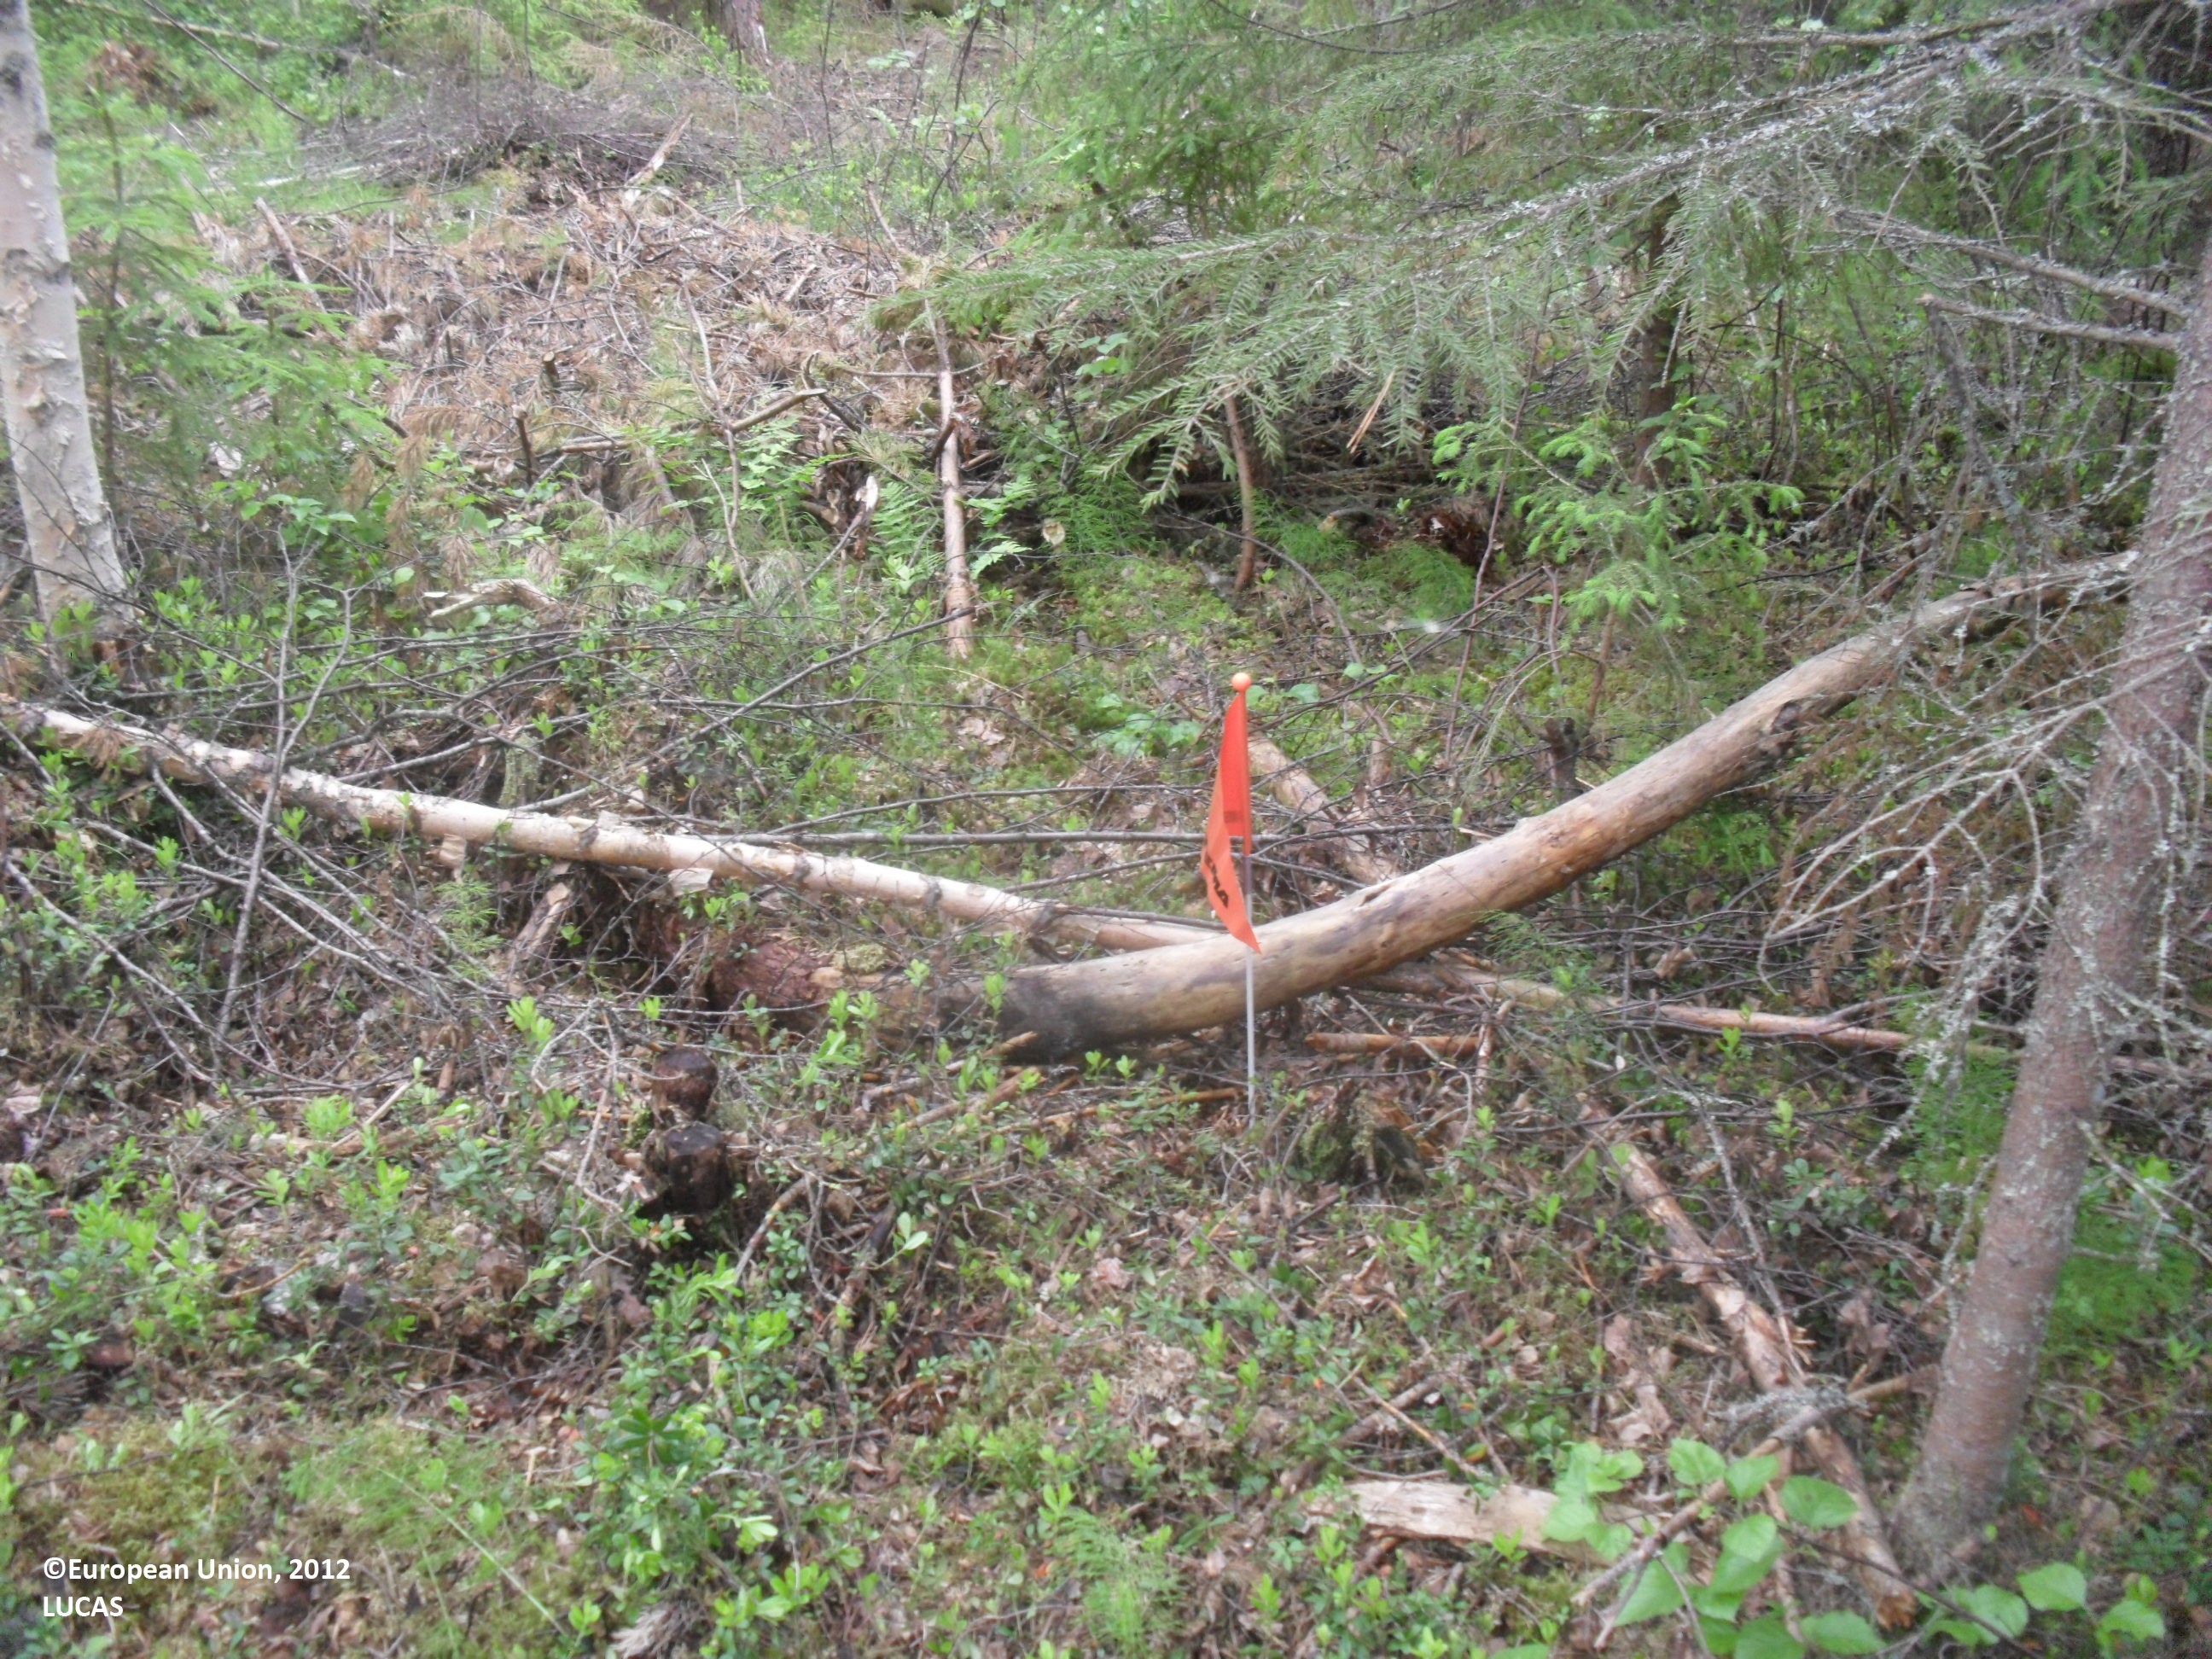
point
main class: Woodland
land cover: Other mixed woodland
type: boreal forest
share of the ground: 50 - 75 %
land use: Forestry
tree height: > 5 m
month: June
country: FI
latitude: 62.9804
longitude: 23.6237
